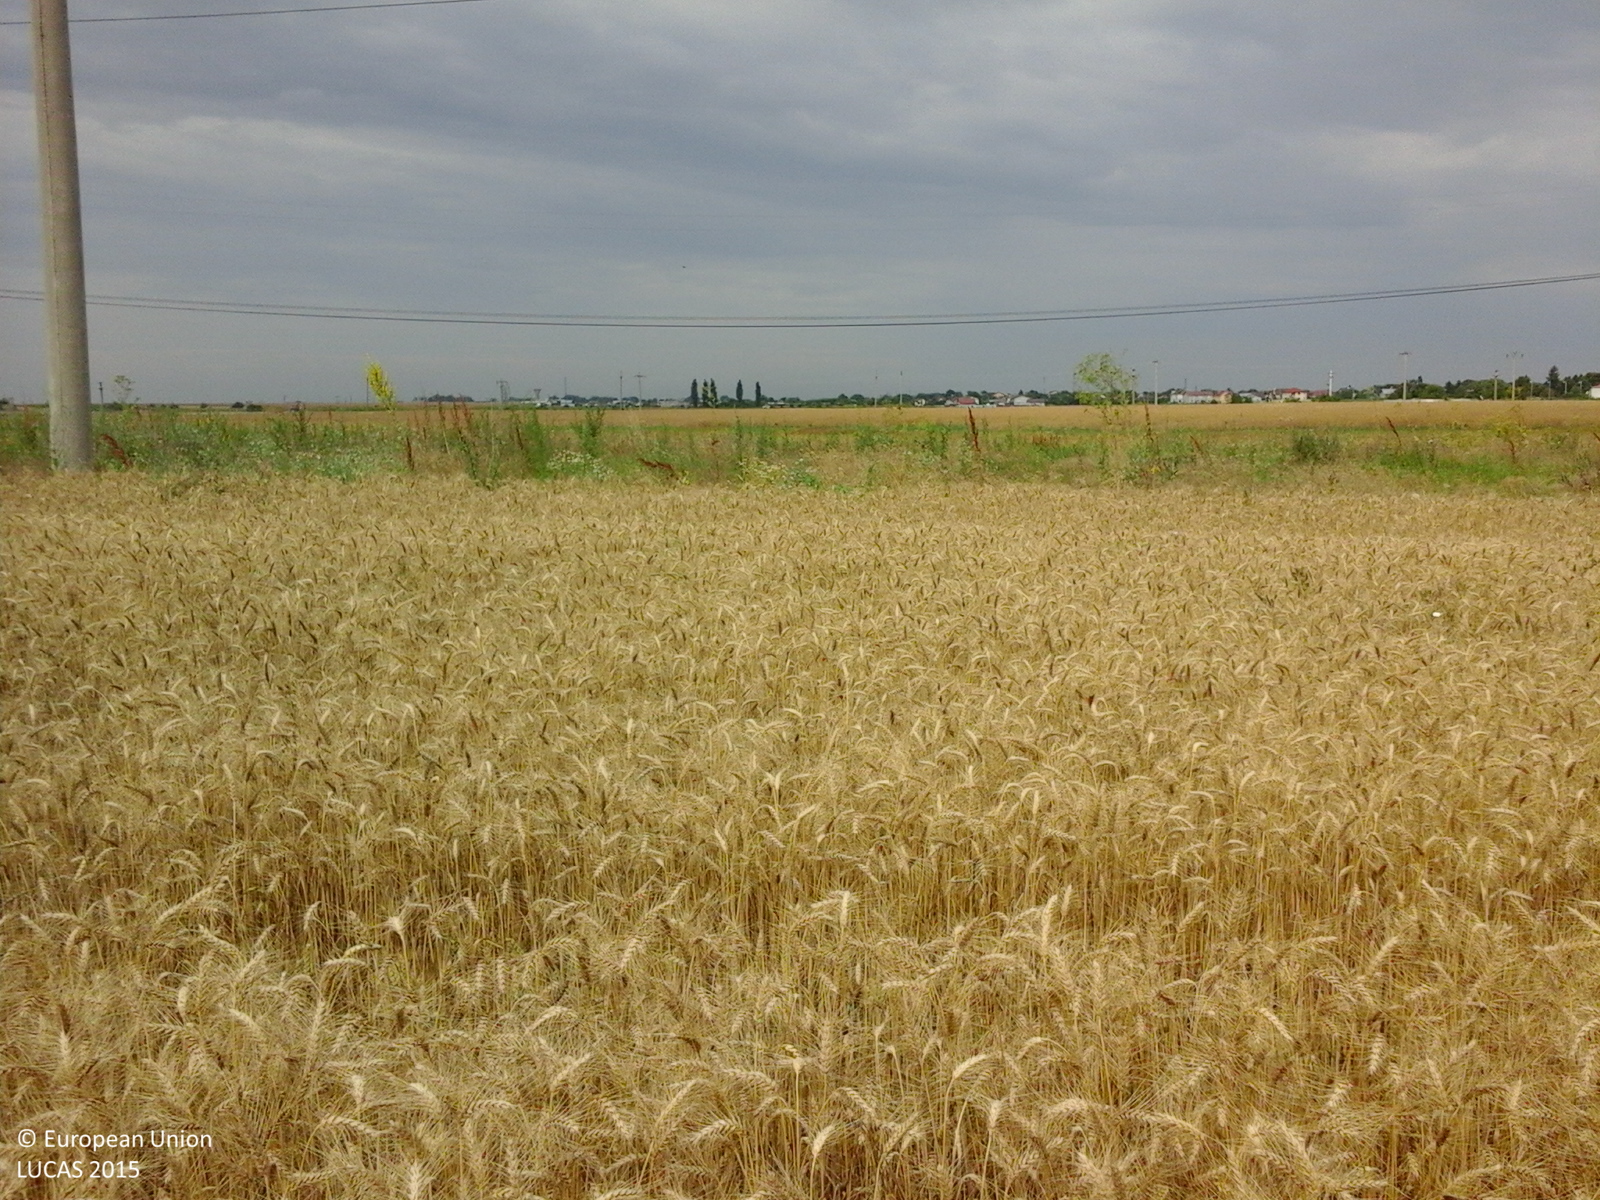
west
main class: Cropland
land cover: Common wheat
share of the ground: > 75 %
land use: Agriculture (excluding fallow land and kitchen gardens)
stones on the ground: < 10 %
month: June
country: RO
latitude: 44.3800
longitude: 26.2619
